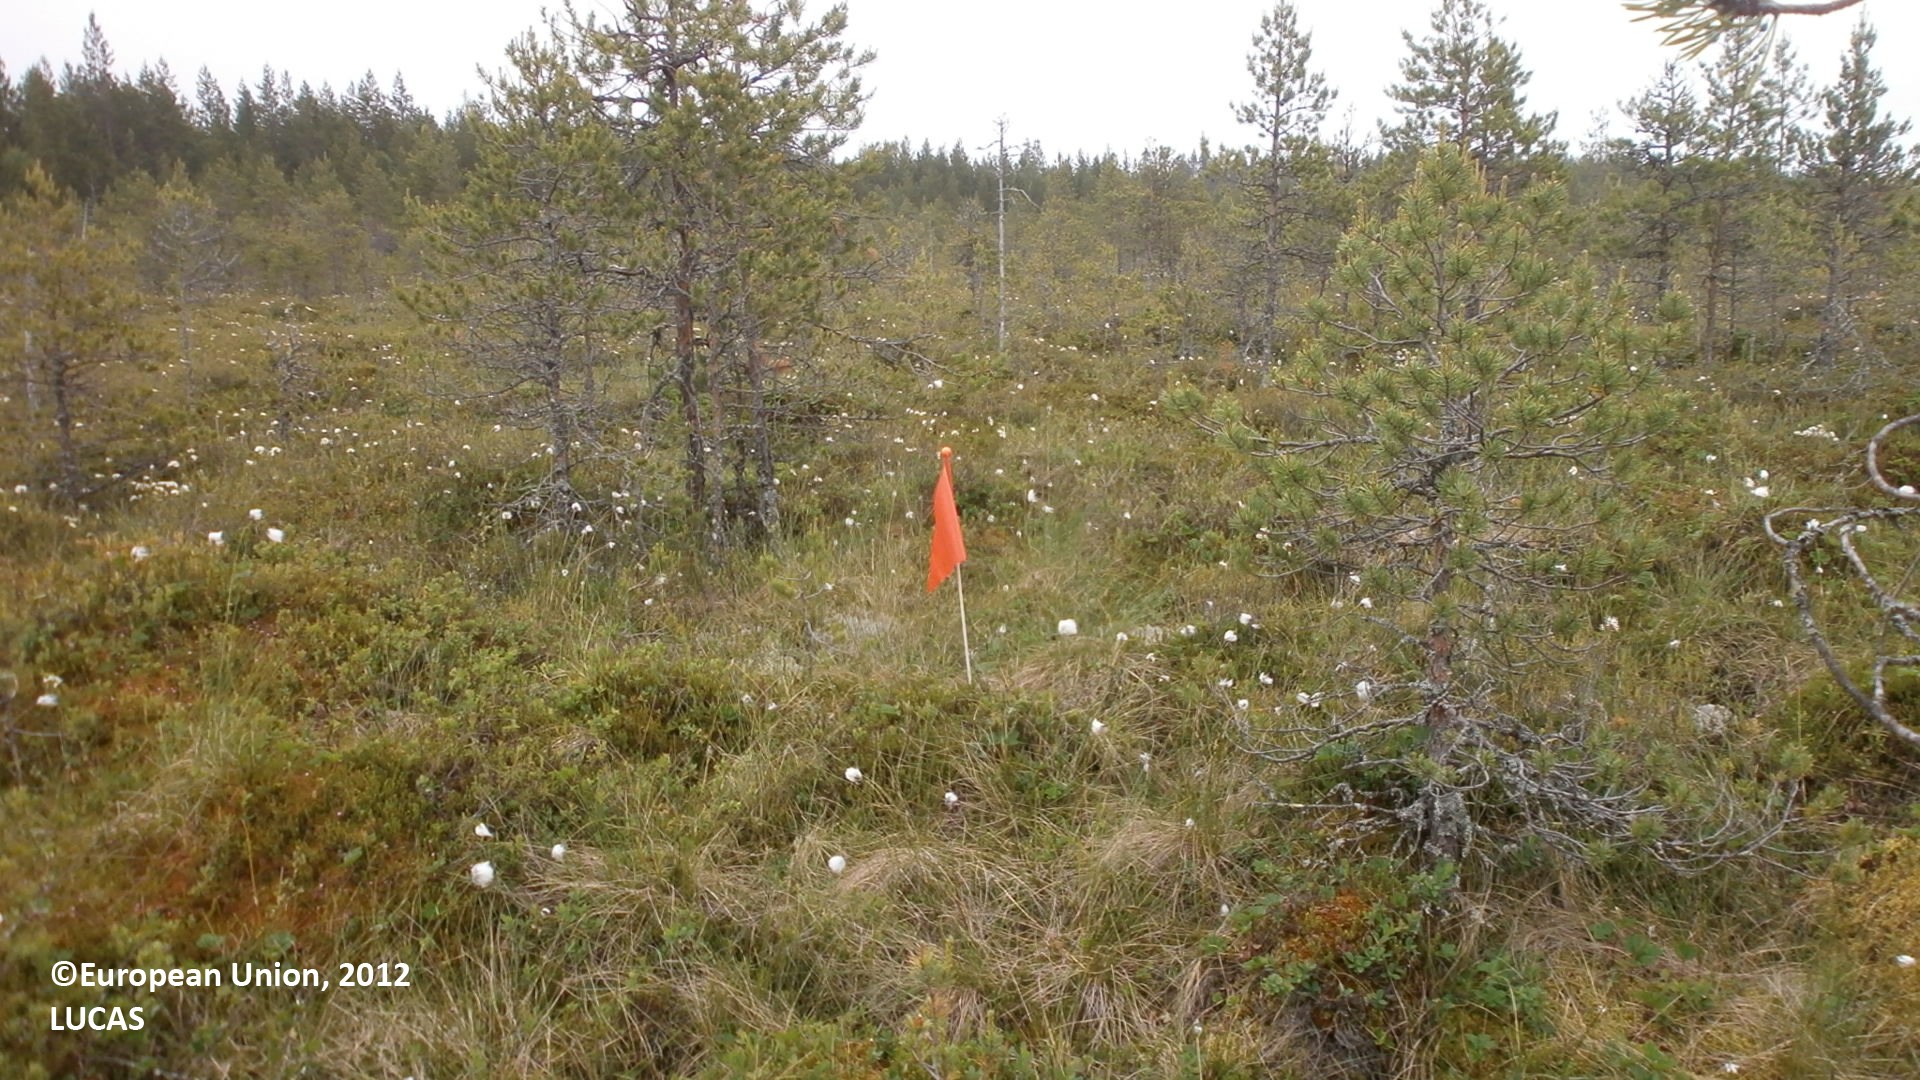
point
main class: Woodland
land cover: Pine dominated coniferous woodland
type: mire and swamp forests
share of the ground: 10 - 25 %
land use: Semi-natural and natural areas not in use
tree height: < 5 m
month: June
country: FI
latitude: 64.5930
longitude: 25.0996
